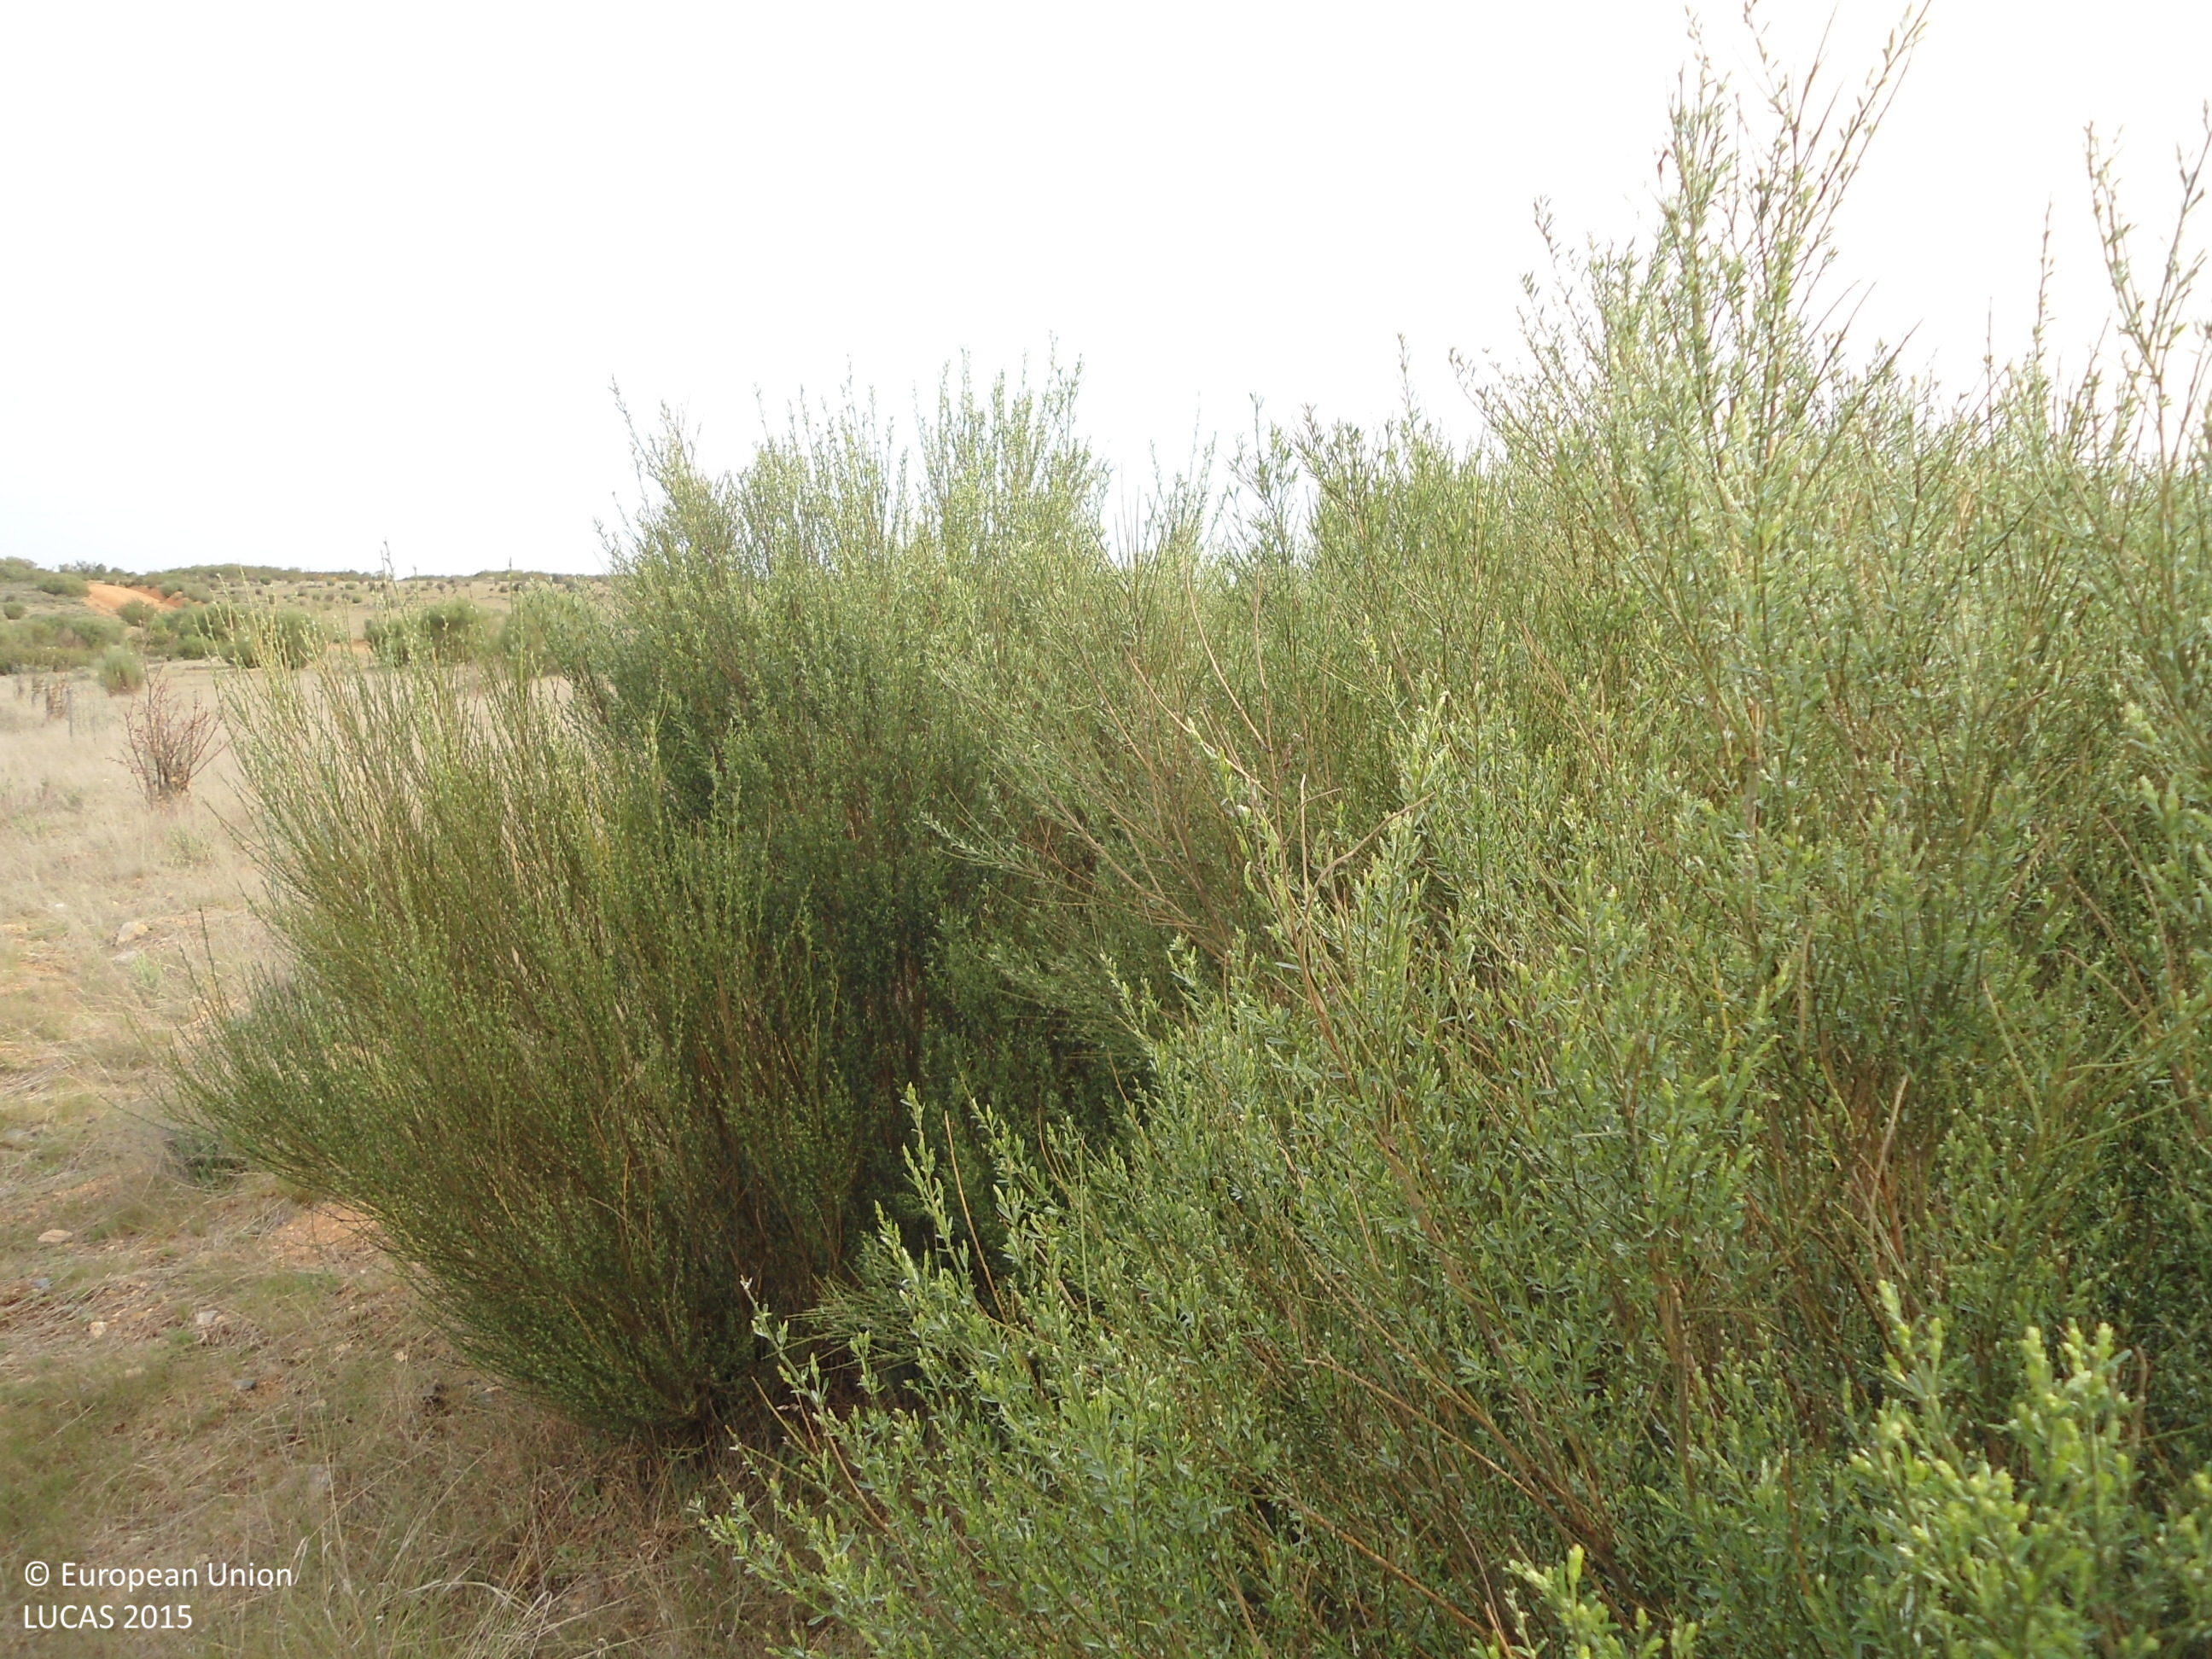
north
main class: Cropland
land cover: Nuts trees
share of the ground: < 10 %
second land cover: Shrubland without tree cover
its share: 50 - 75 %
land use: Abandoned areas
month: April
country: ES
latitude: 41.7462
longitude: -6.5211
